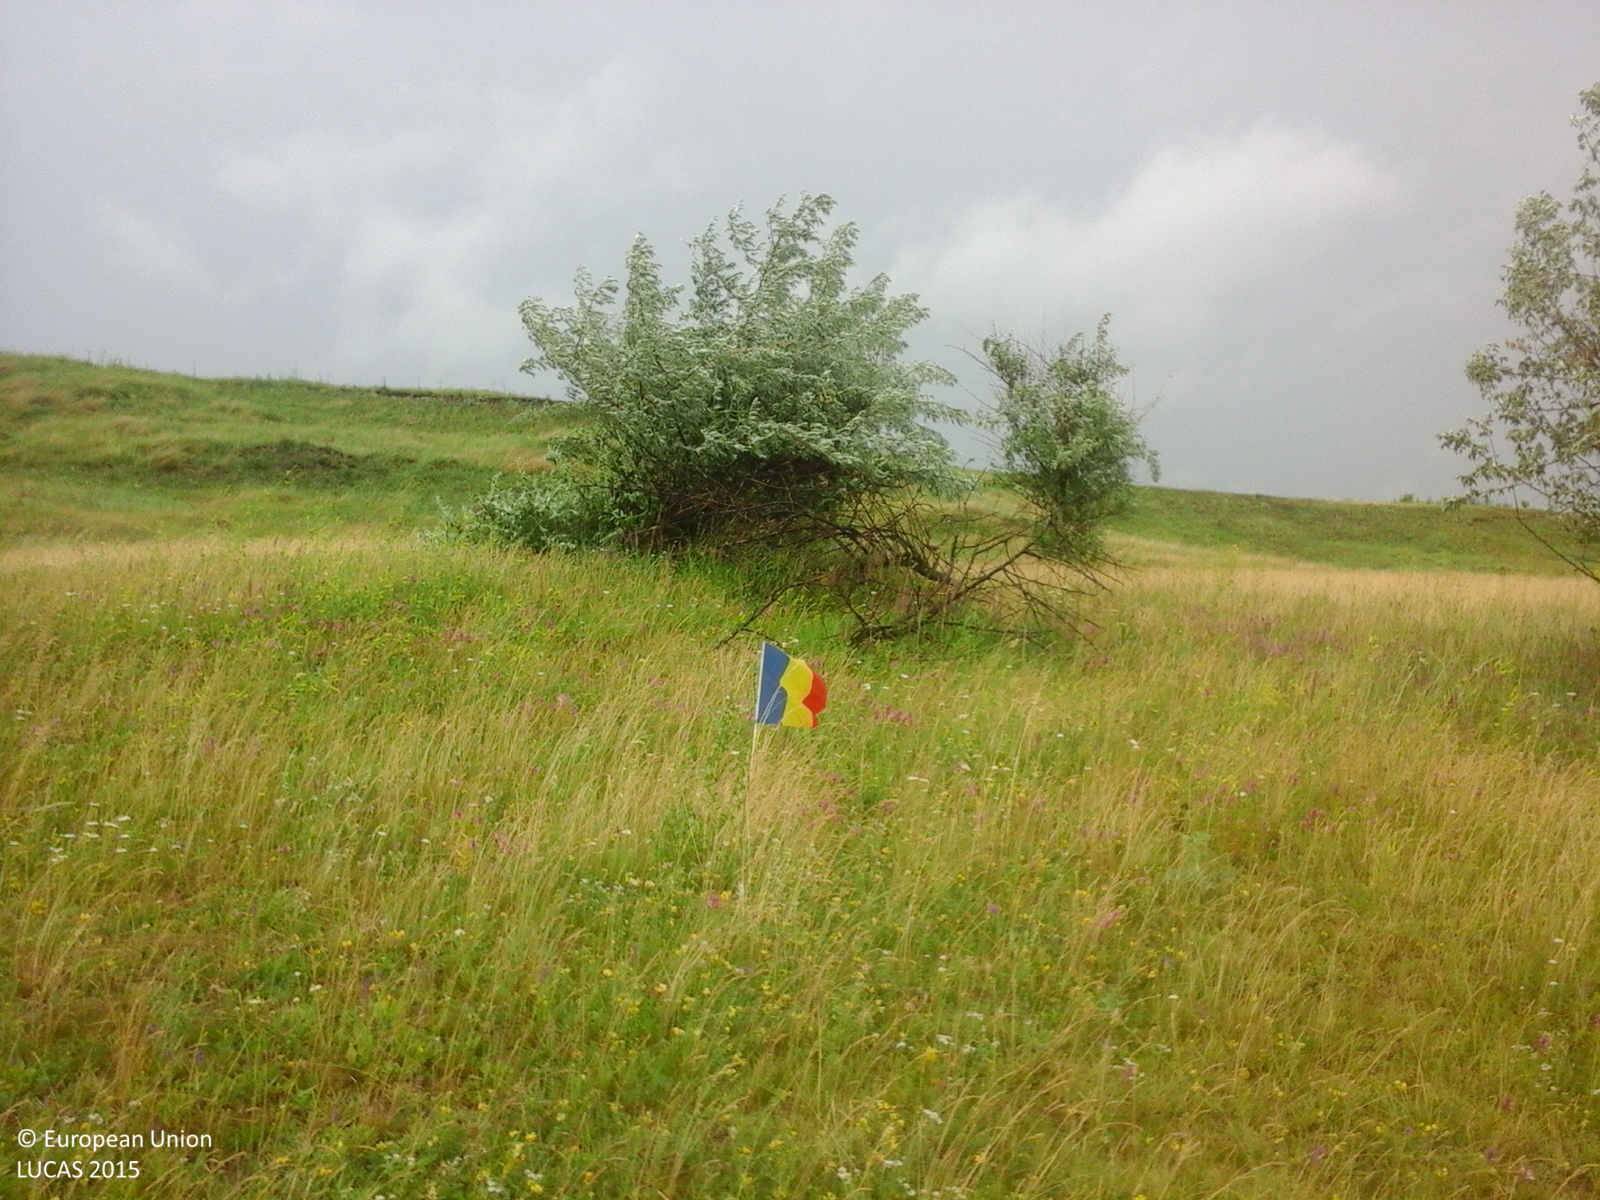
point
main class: Grassland
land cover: Grassland with sparse tree/shrub cover
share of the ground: > 75 %
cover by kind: herbaceous plants 90 %, broadleaved forest trees 5 %, shrubs 5 %
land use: Agriculture (excluding fallow land and kitchen gardens)
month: June
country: RO
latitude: 47.9273
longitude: 26.5966
